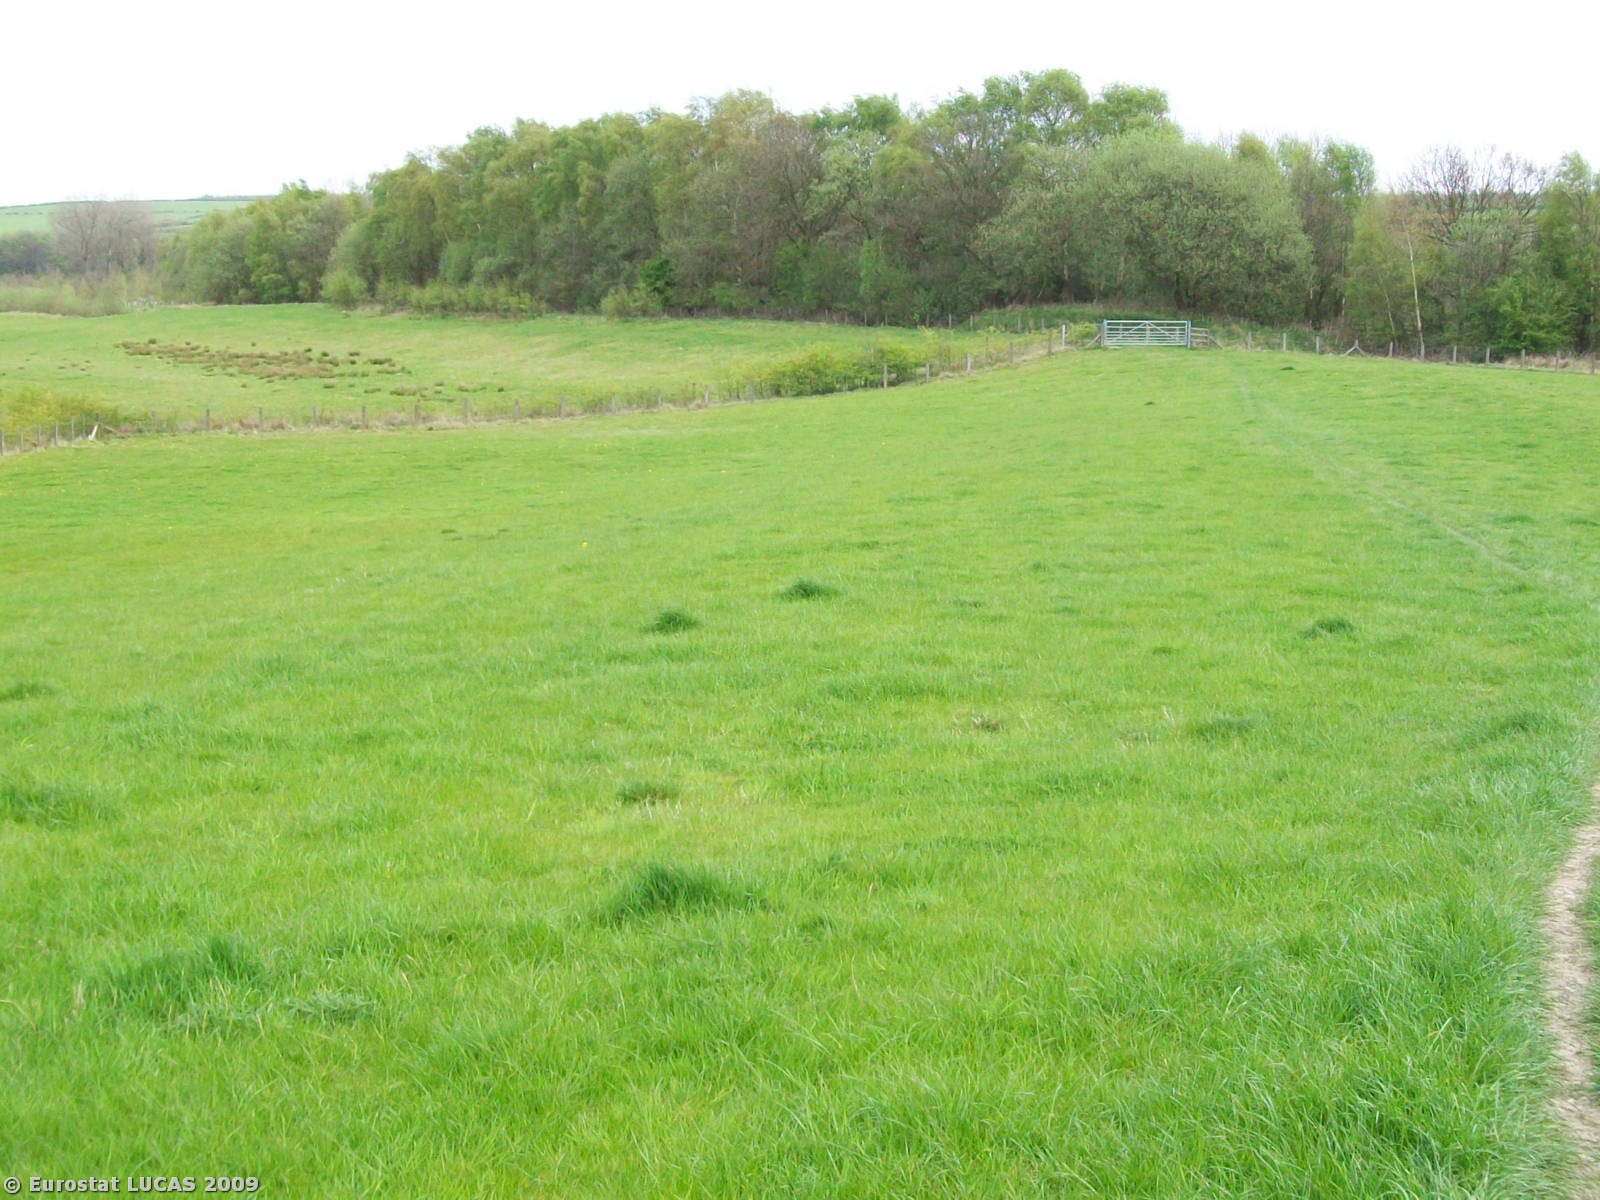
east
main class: Grassland
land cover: Grassland without tree/shrub cover
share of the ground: > 75 %
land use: Agriculture (excluding fallow land and kitchen gardens)
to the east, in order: Grassland without tree/shrub cover; Fences; Managed hedges; Fences; Grassland without tree/shrub cover; Fences; Broadleaved woodland; Fences; Grassland without tree/shrub cover; Fences; Abandoned hedges
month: April
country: GB
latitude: 53.0227
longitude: -1.4246
